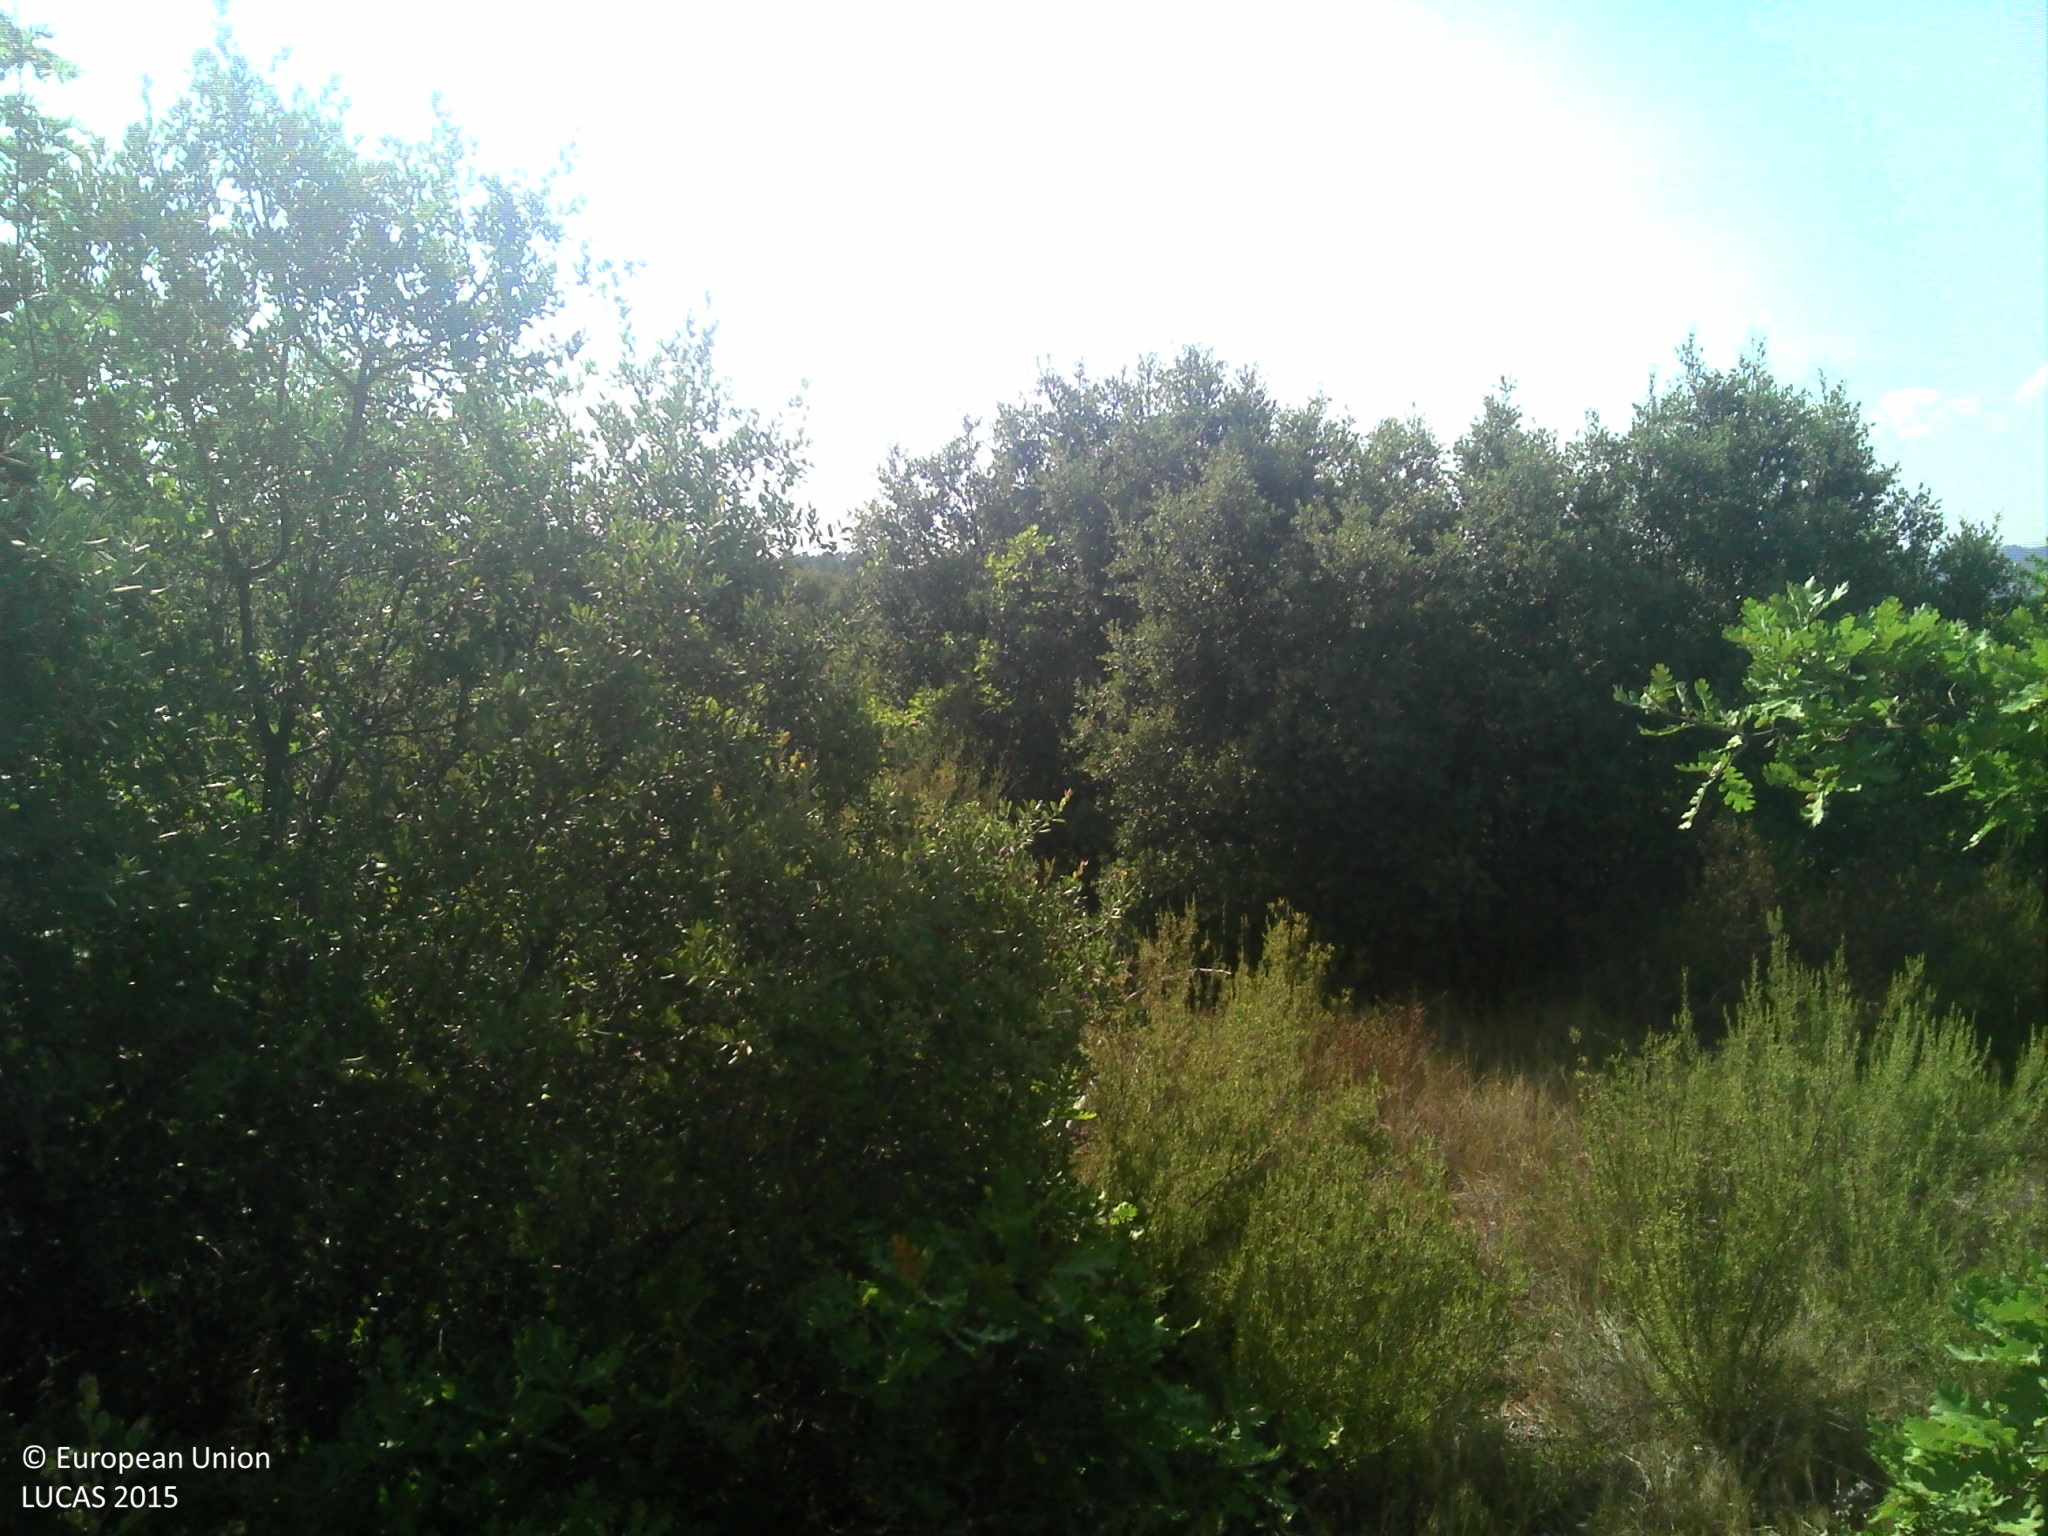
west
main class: Shrubland
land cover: Shrubland with sparse tree cover
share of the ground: > 75 %
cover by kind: shrubs 50 %, herbaceous plants 30 %, unconsolidated bare surface 10 %, broadleaved forest trees 5 %, lichens and mosses 5 %
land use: Forestry
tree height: < 5 m
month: August
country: FR
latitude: 43.6264
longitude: 5.6344
